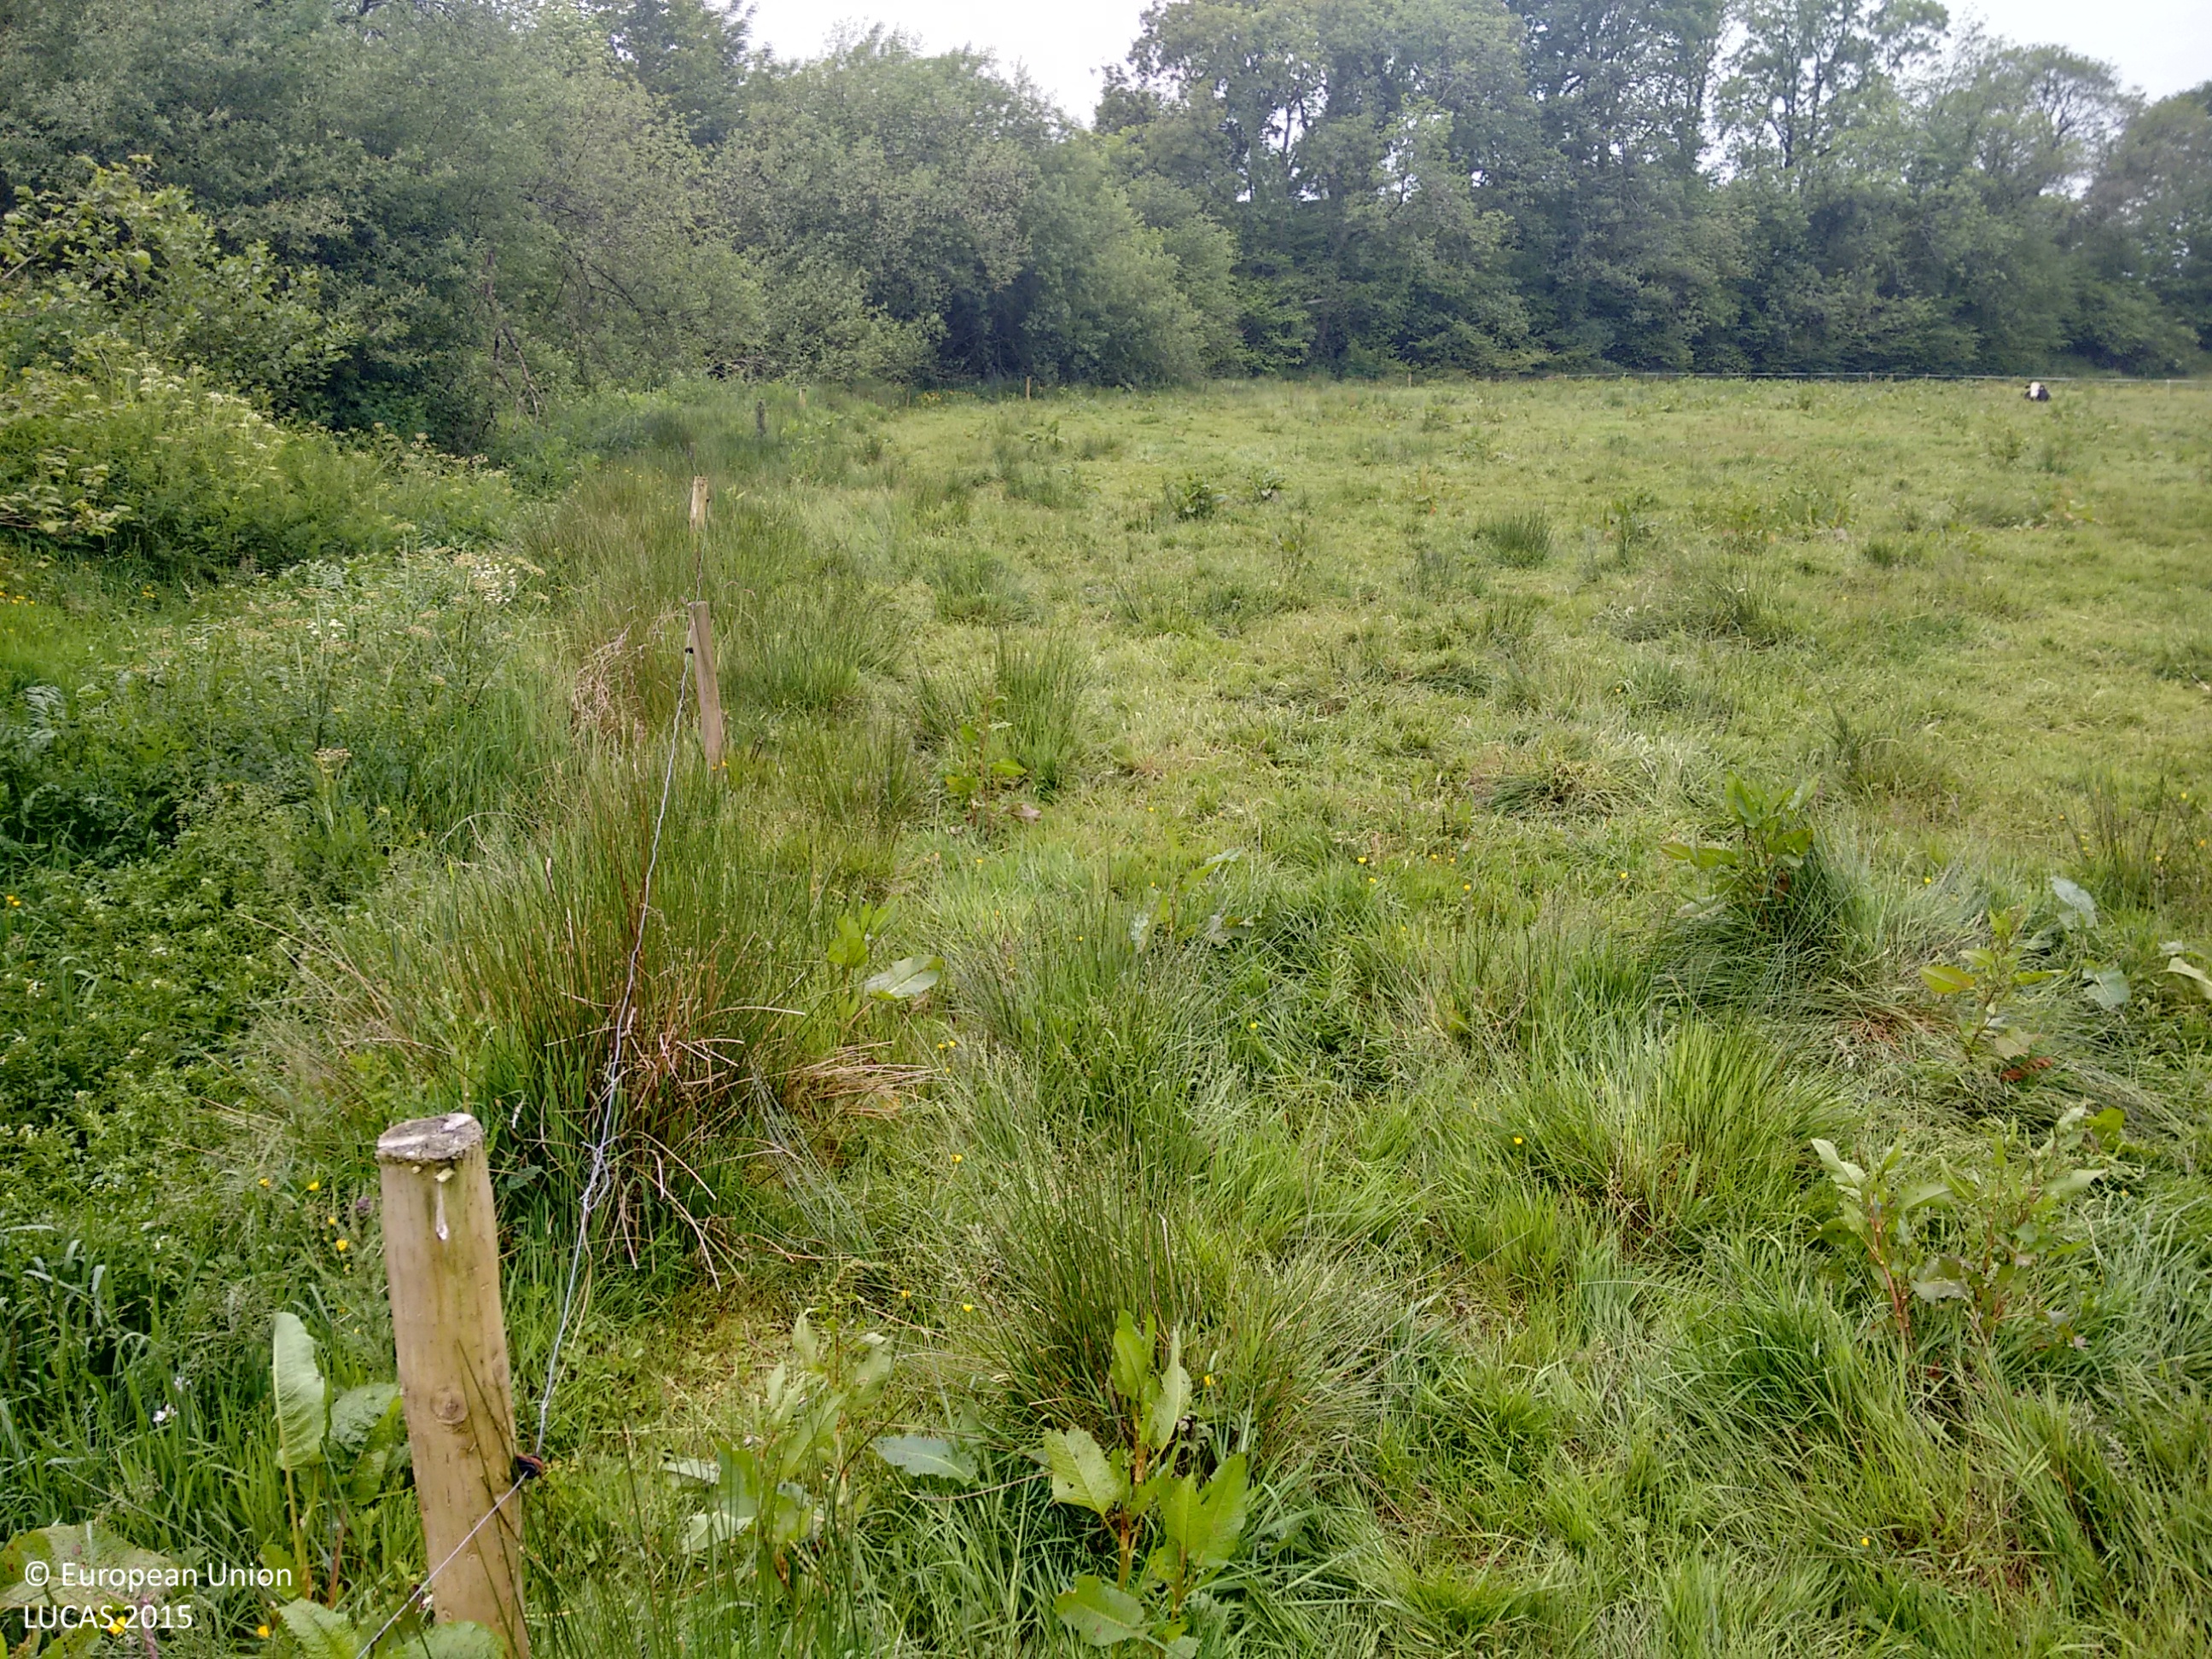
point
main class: Grassland
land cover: Grassland without tree/shrub cover
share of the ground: > 75 %
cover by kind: herbaceous plants 100 %
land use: Agriculture (excluding fallow land and kitchen gardens)
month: June
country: IE
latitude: 52.0513
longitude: -8.3738
